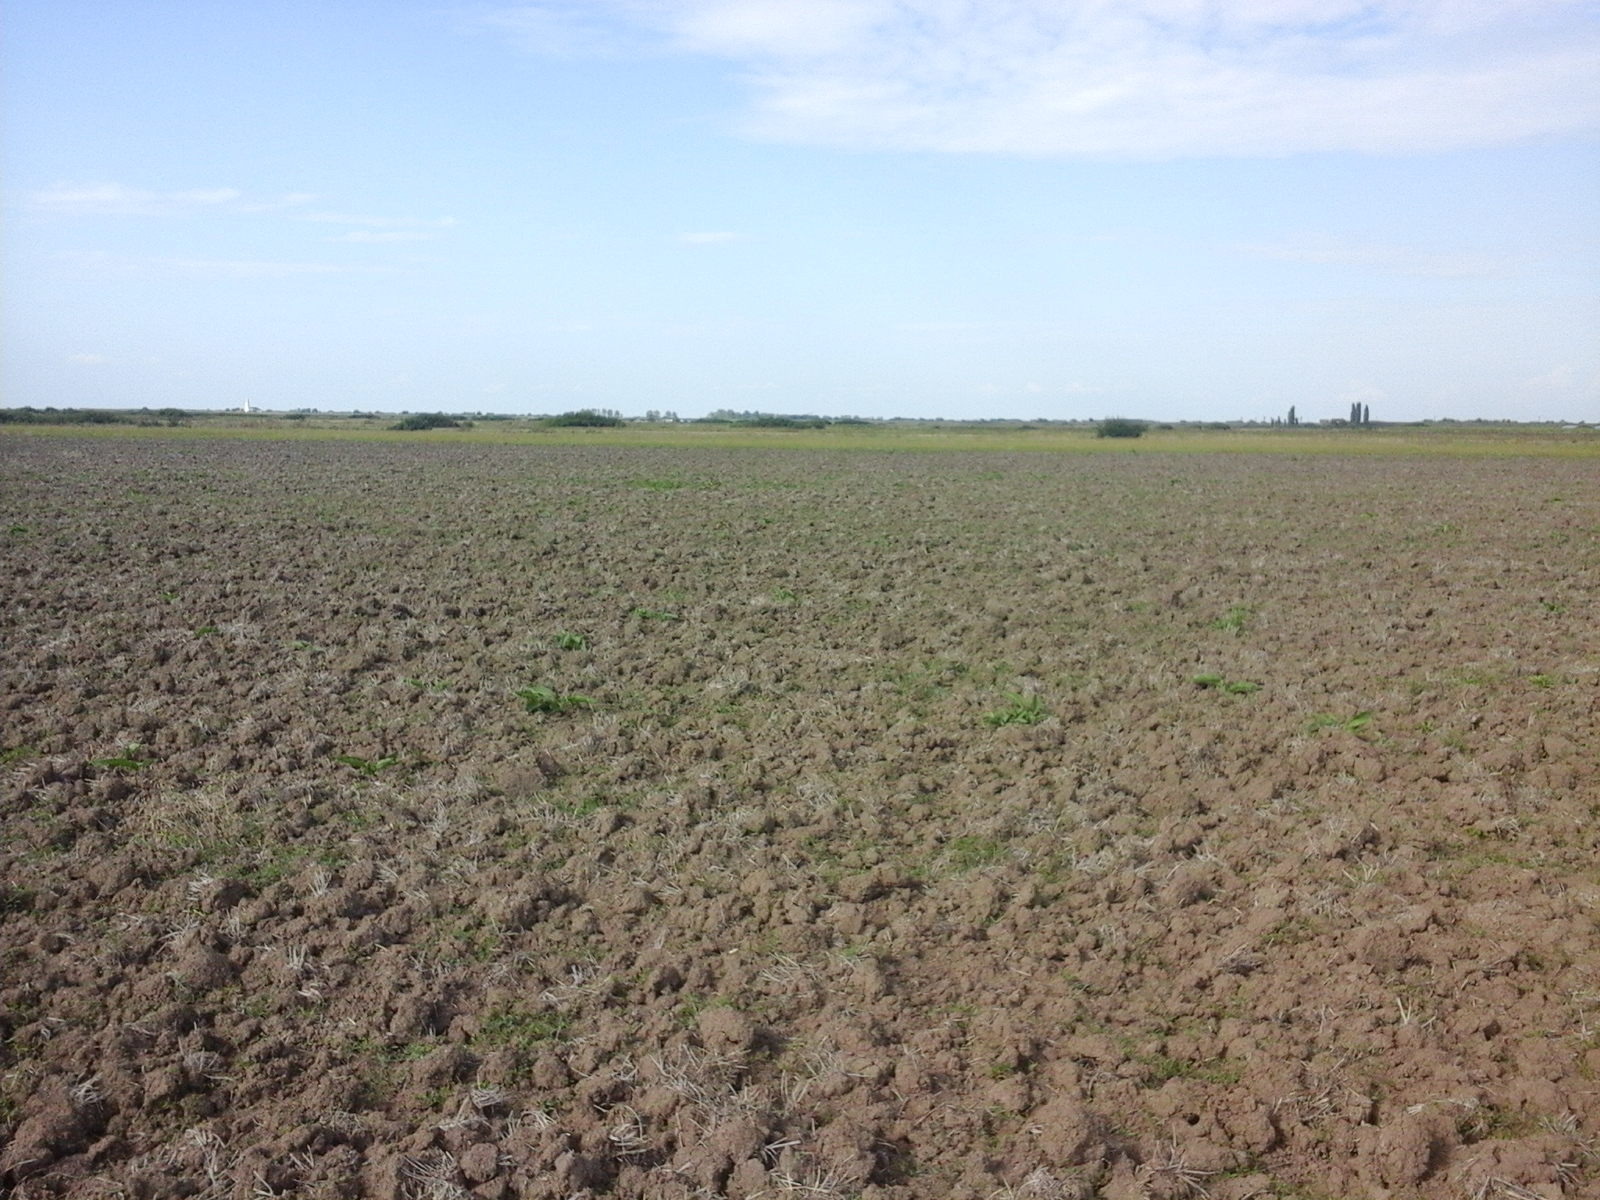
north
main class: Cropland
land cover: Common wheat
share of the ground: < 10 %
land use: Agriculture (excluding fallow land and kitchen gardens)
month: August
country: RO
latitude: 46.6412
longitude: 21.4692
